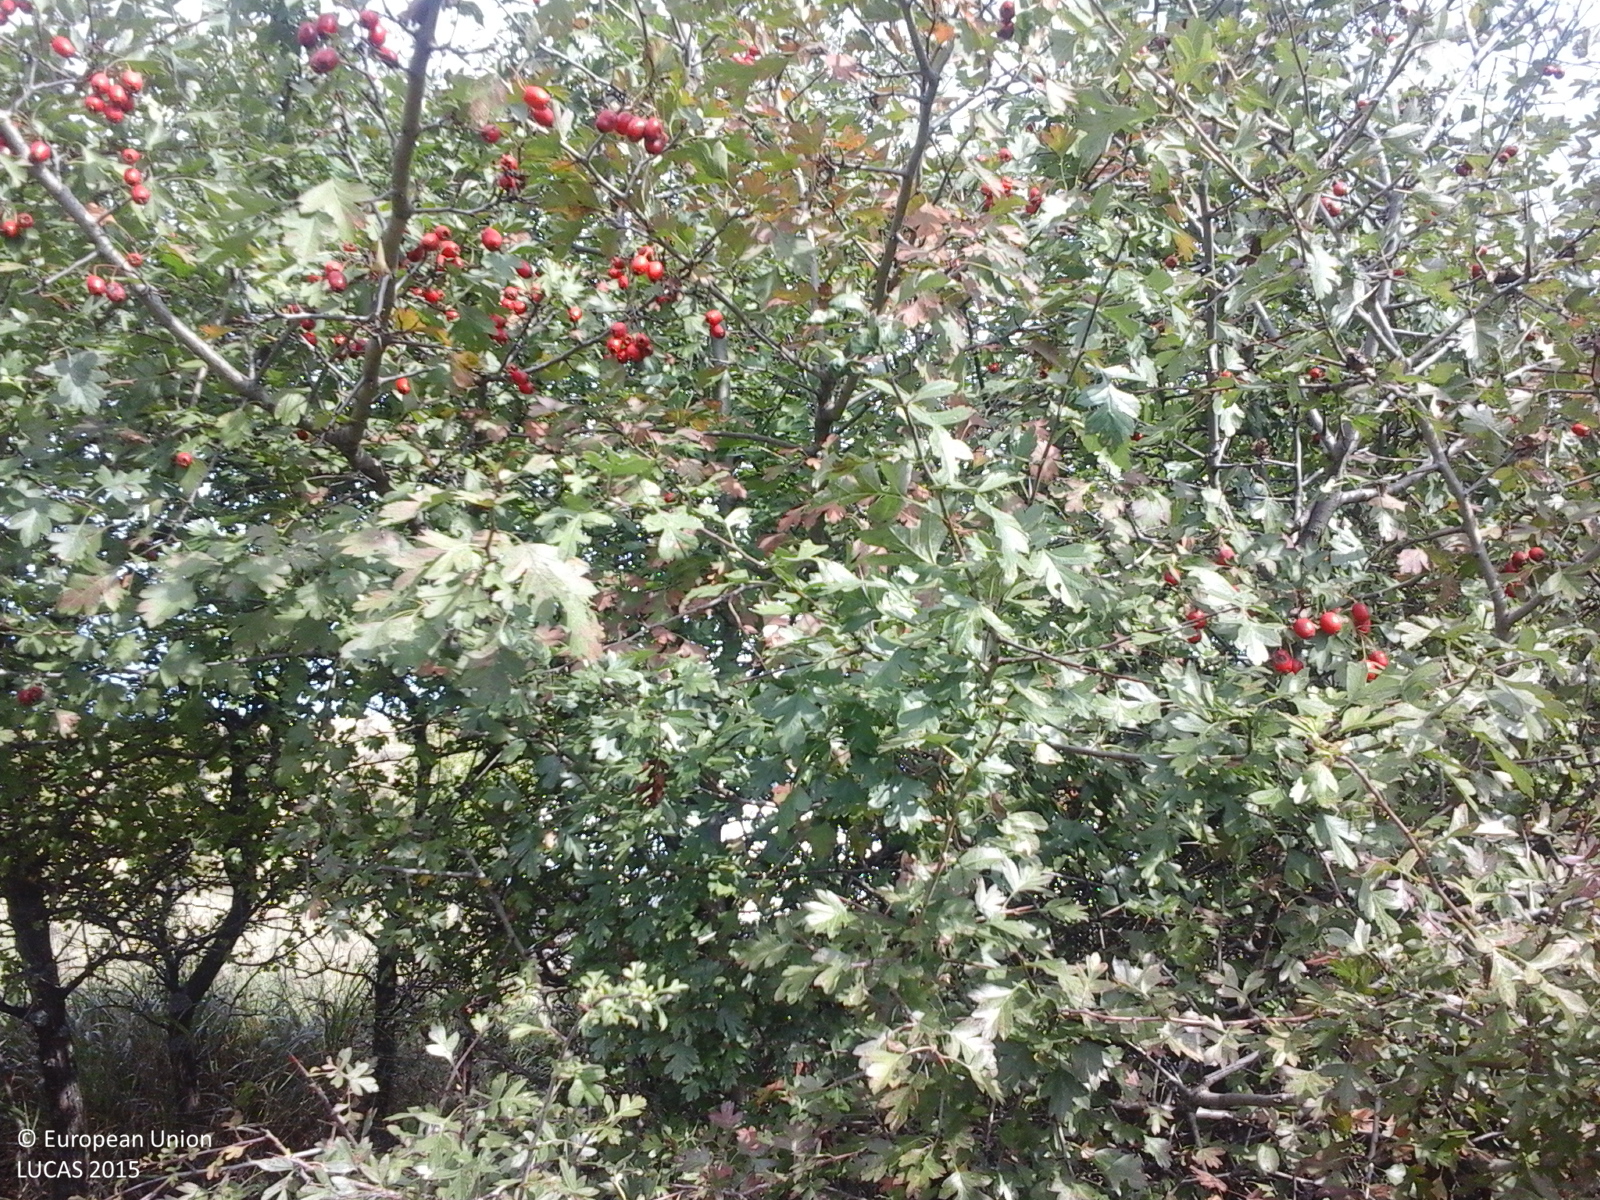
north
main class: Grassland
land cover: Grassland with sparse tree/shrub cover
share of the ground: > 75 %
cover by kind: herbaceous plants 85 %, shrubs 10 %, broadleaved forest trees 5 %
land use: Agriculture (excluding fallow land and kitchen gardens)
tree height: < 5 m
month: September
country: RO
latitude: 46.6776
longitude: 23.4945
